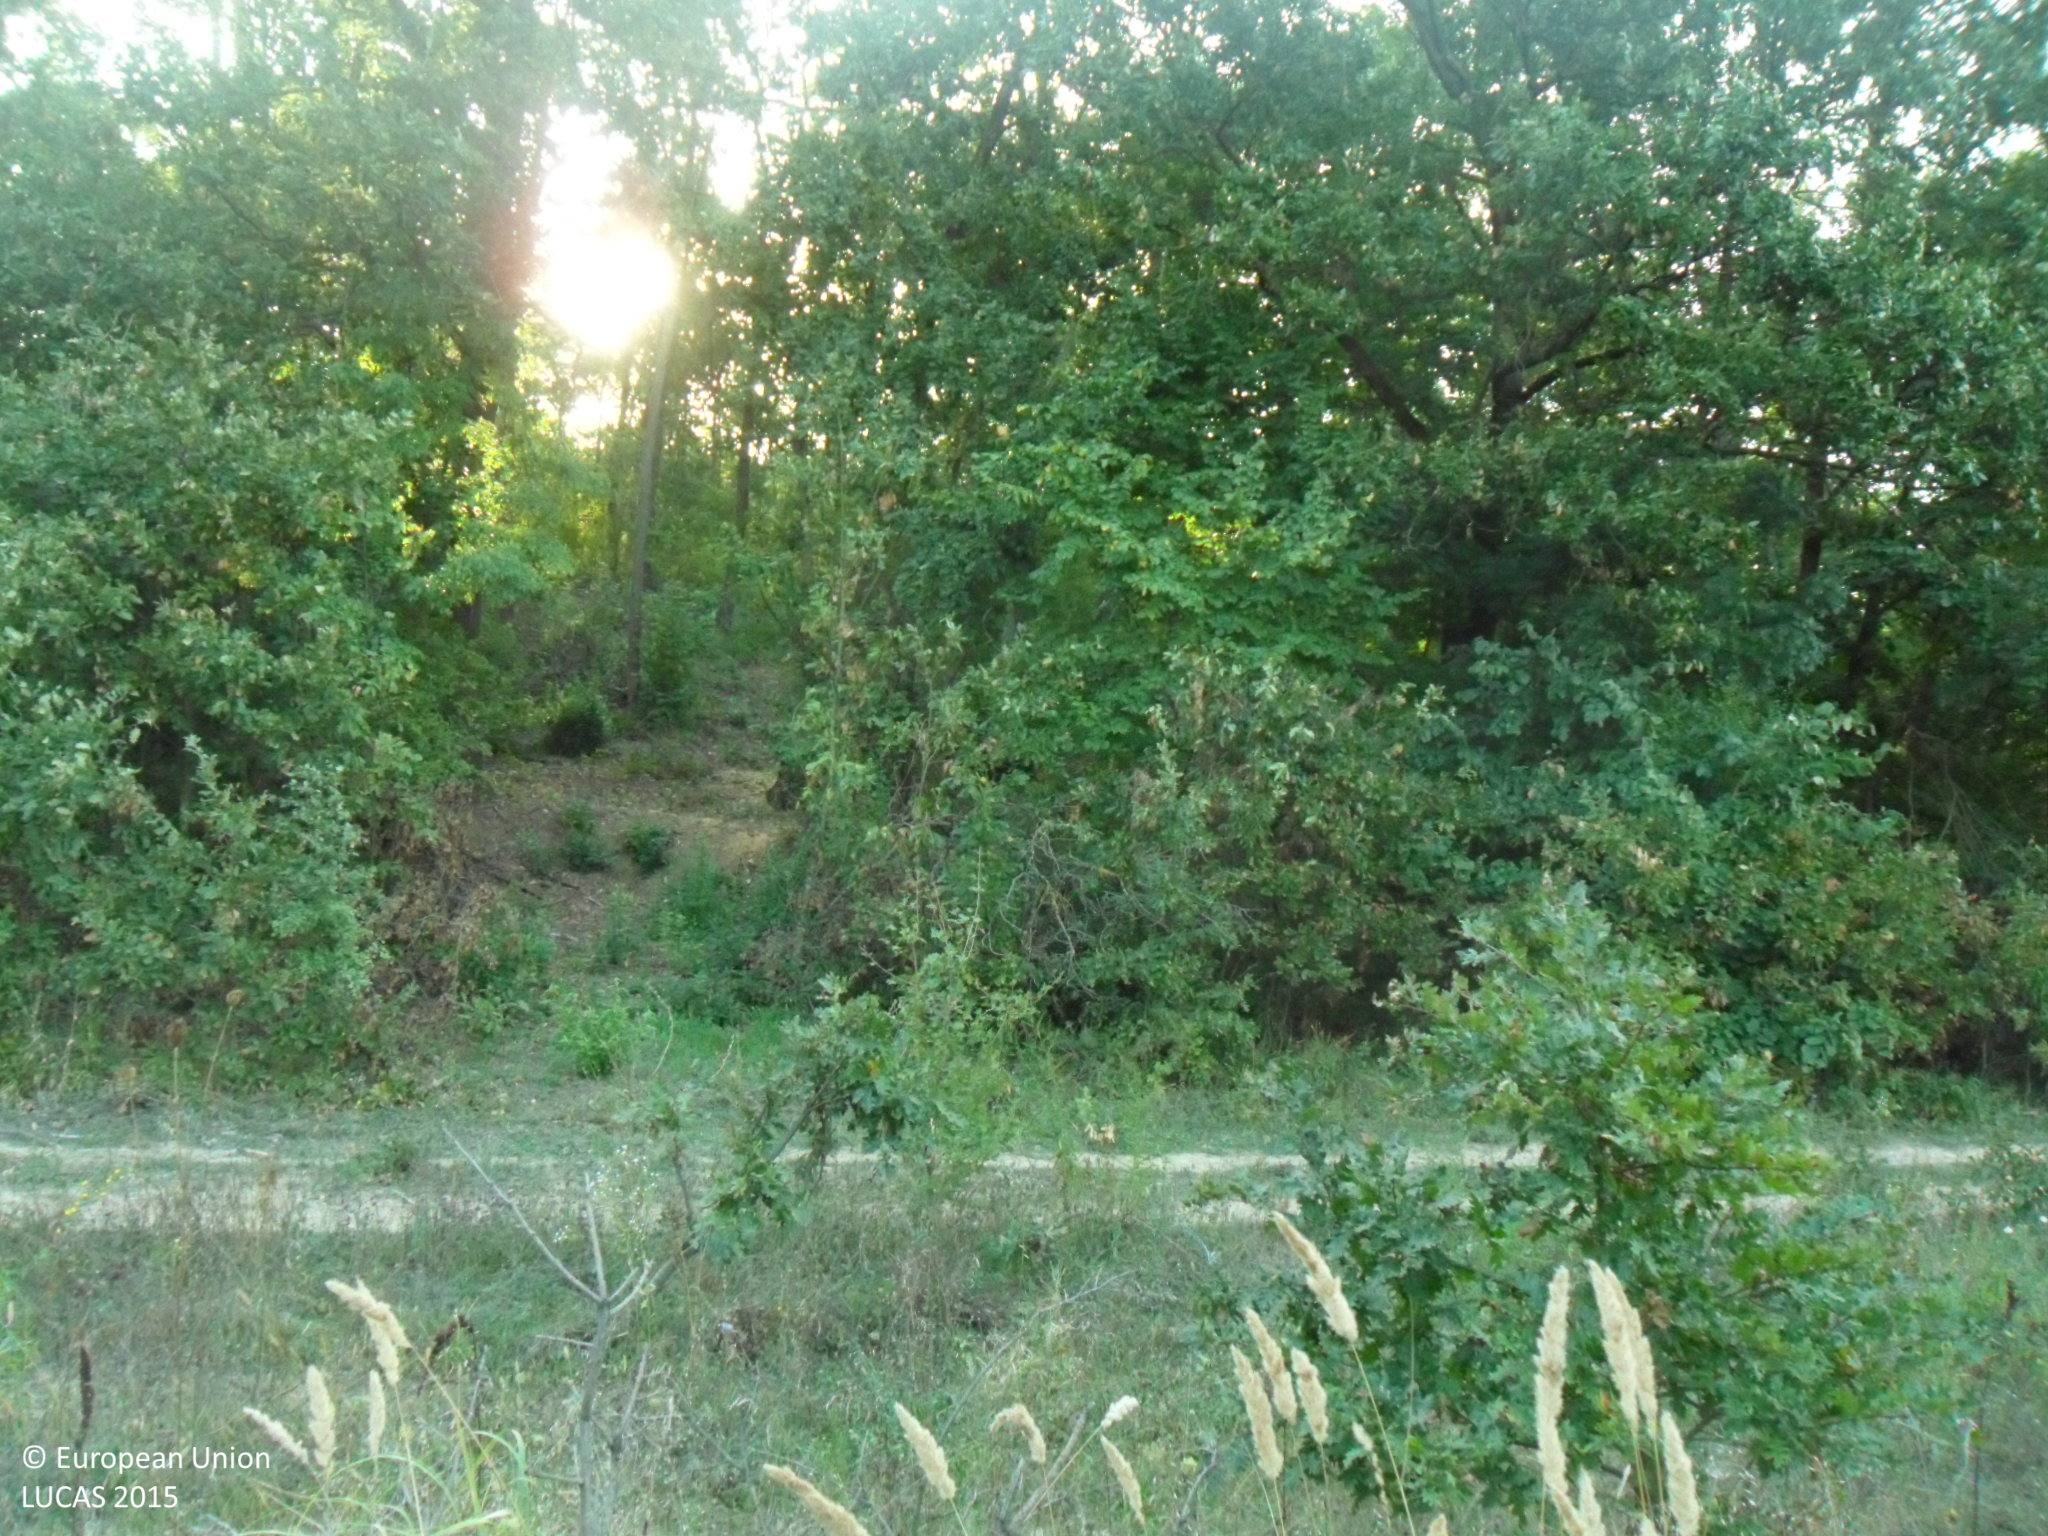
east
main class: Shrubland
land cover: Shrubland with sparse tree cover
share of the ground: > 75 %
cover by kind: shrubs 75 %, herbaceous plants 20 %, broadleaved forest trees 5 %
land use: Agriculture (excluding fallow land and kitchen gardens)
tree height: < 5 m
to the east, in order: Shrubland with sparse tree cover; Tracks; Broadleaved woodland; Tracks; Broadleaved woodland
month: September
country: BG
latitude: 43.6211
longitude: 26.2978
